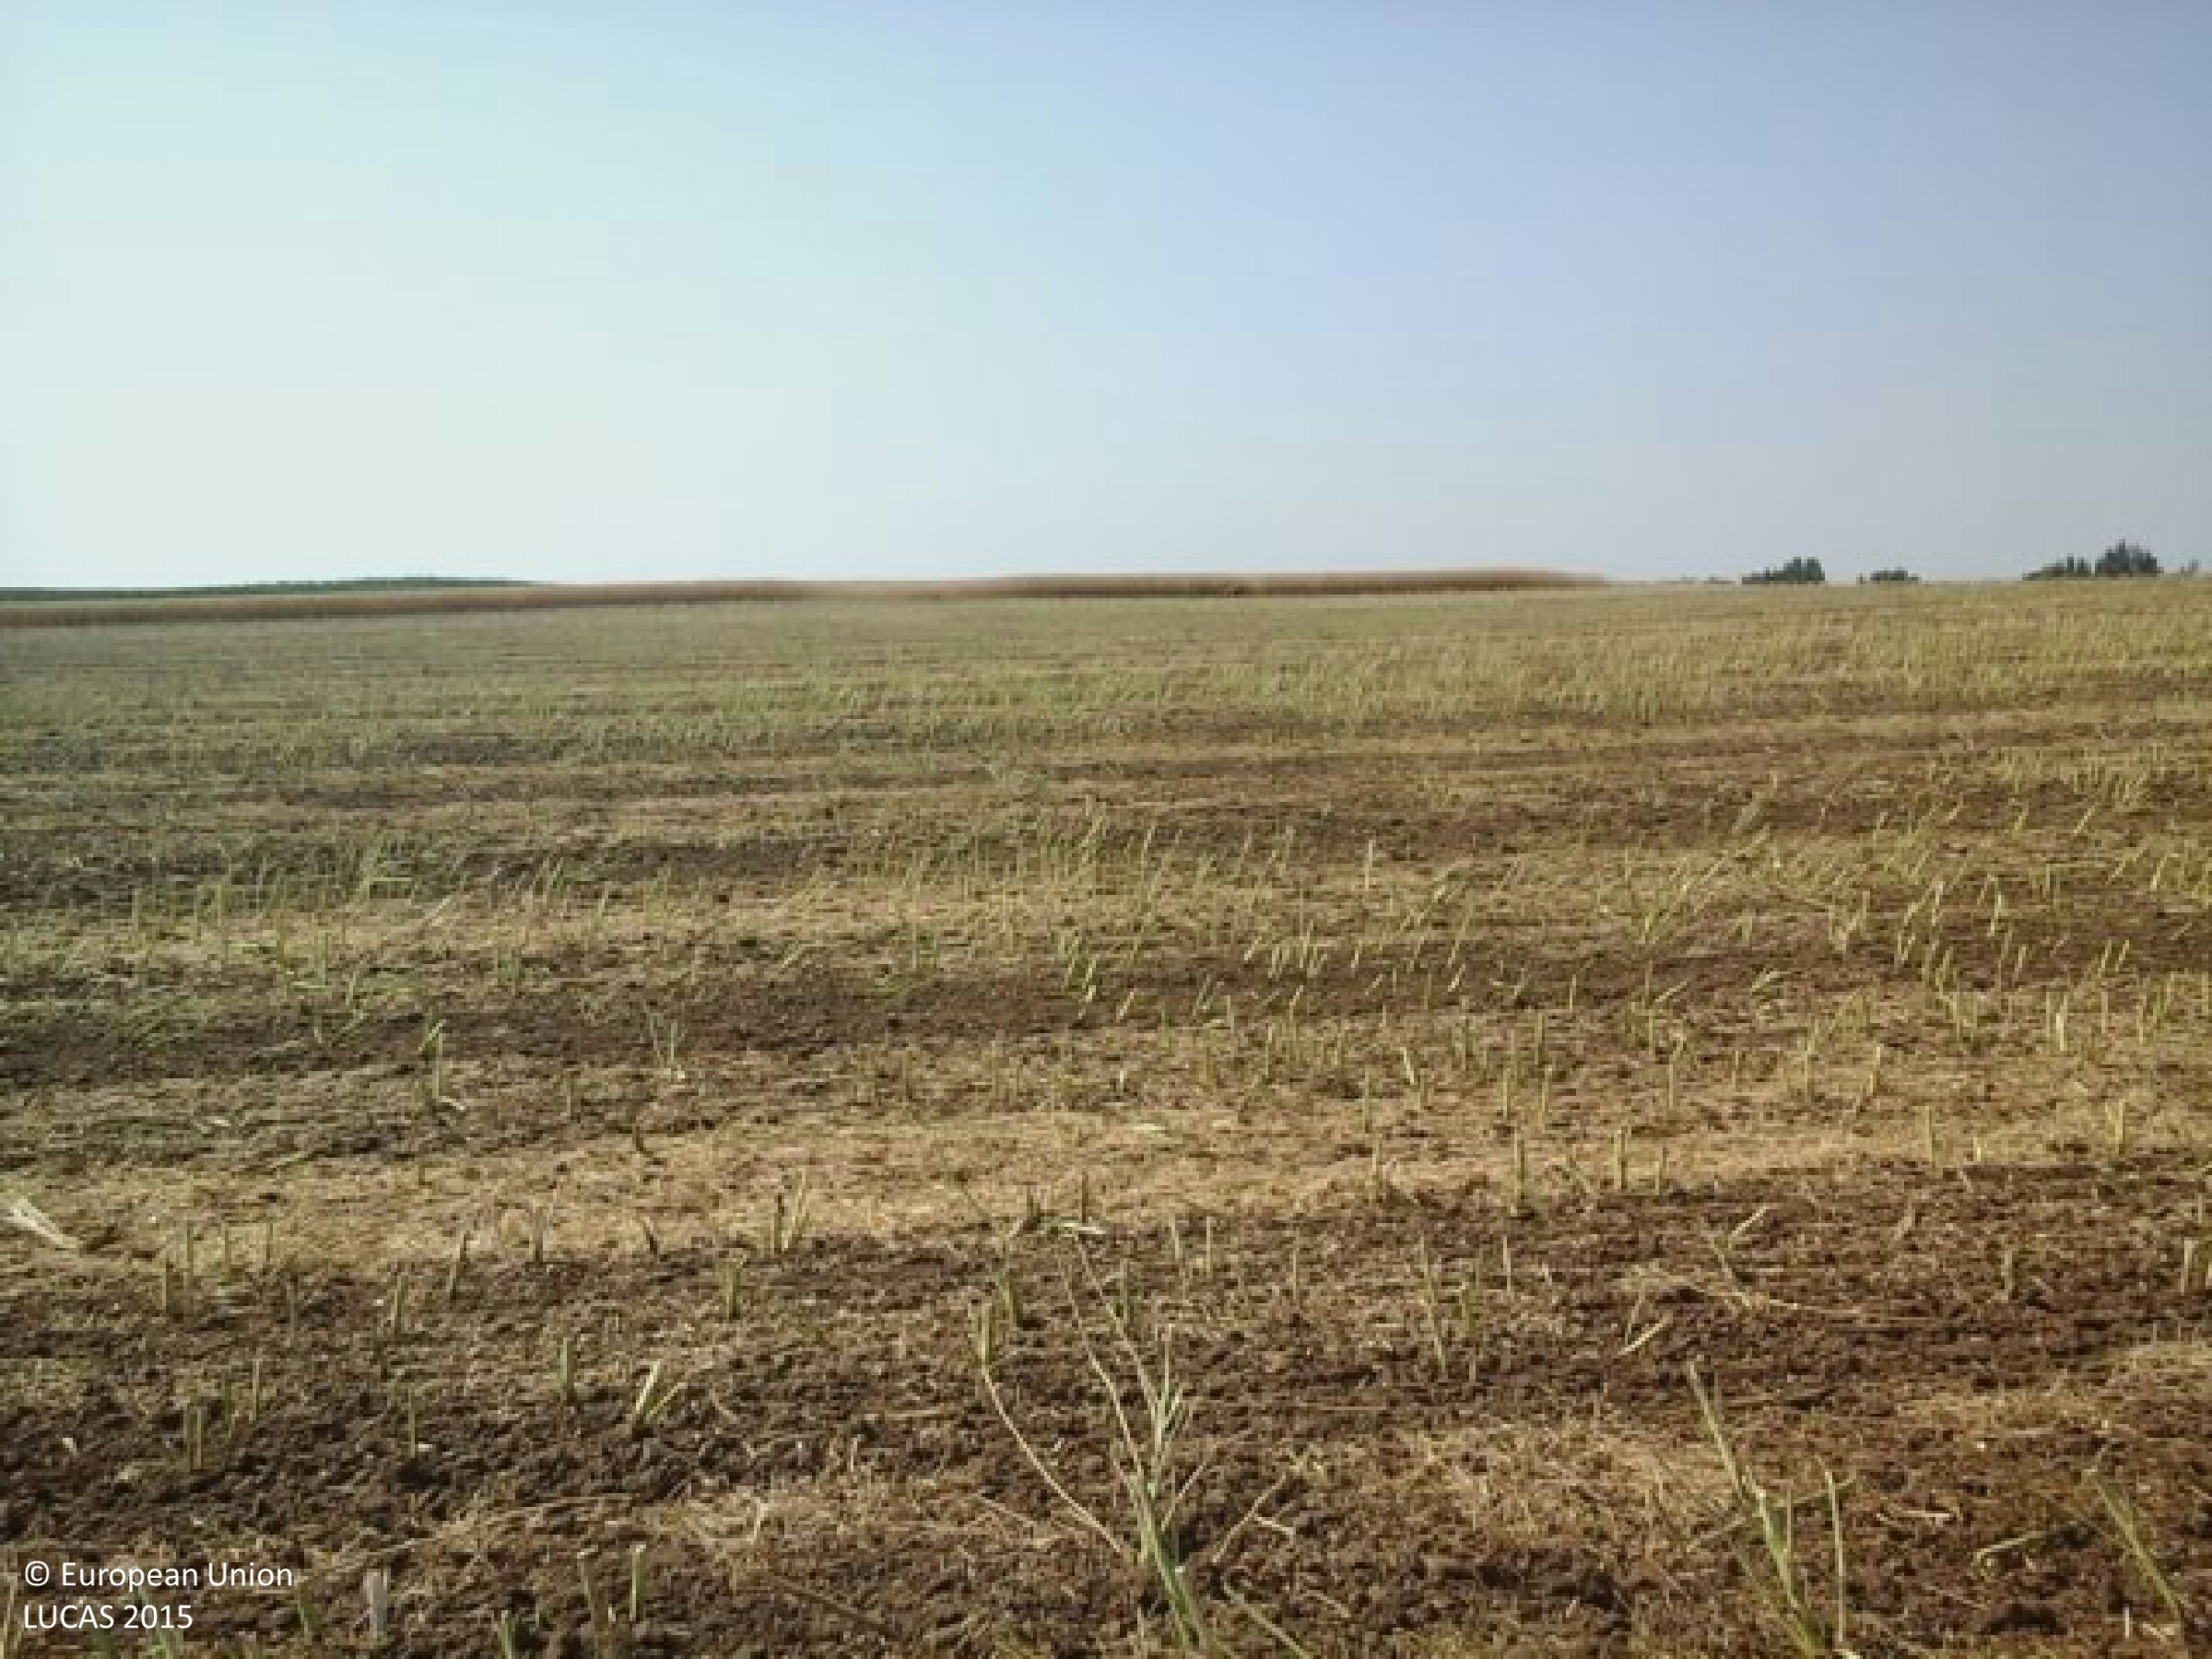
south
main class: Cropland
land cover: Rape and turnip rape
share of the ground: < 10 %
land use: Agriculture (excluding fallow land and kitchen gardens)
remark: Harvested field
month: July
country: HU
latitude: 46.1561
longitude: 19.1683
